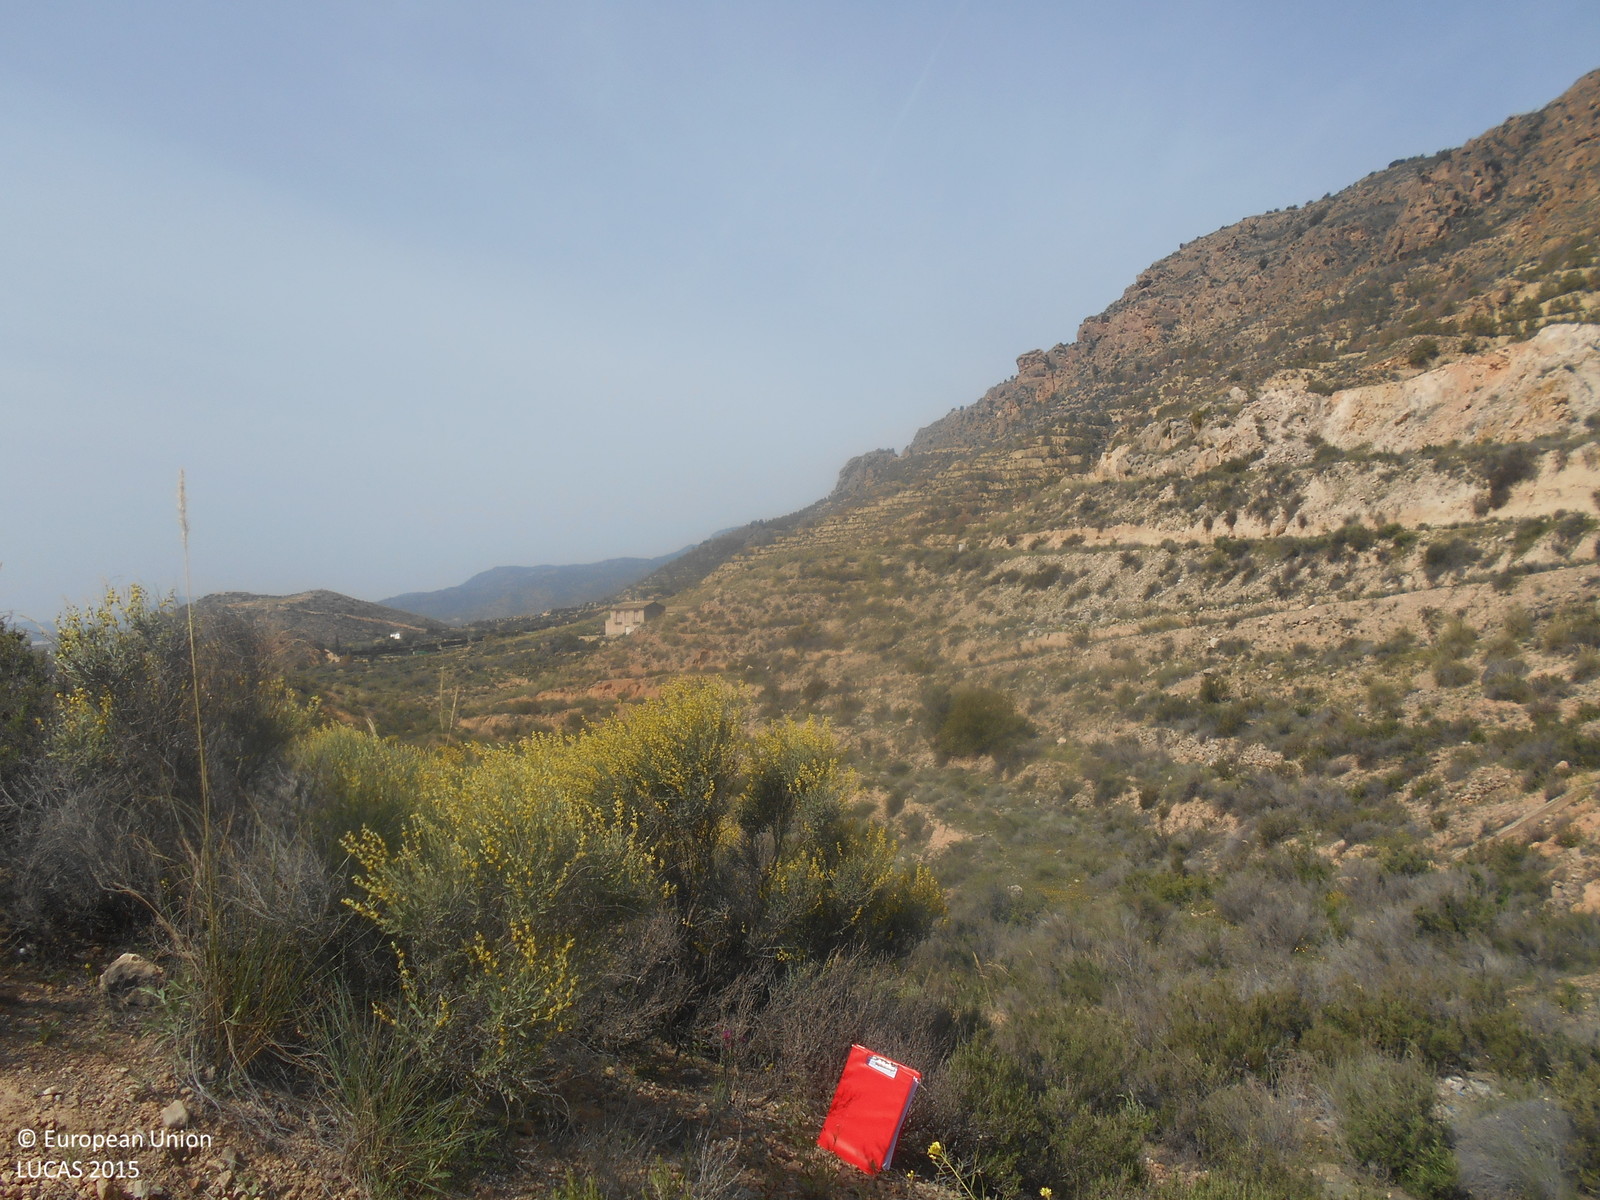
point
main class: Shrubland
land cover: Shrubland without tree cover
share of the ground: 25 - 50 %
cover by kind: shrubs 40 %, unconsolidated bare surface 40 %, herbaceous plants 20 %
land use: Semi-natural and natural areas not in use
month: April
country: ES
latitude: 37.8637
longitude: -1.4074
